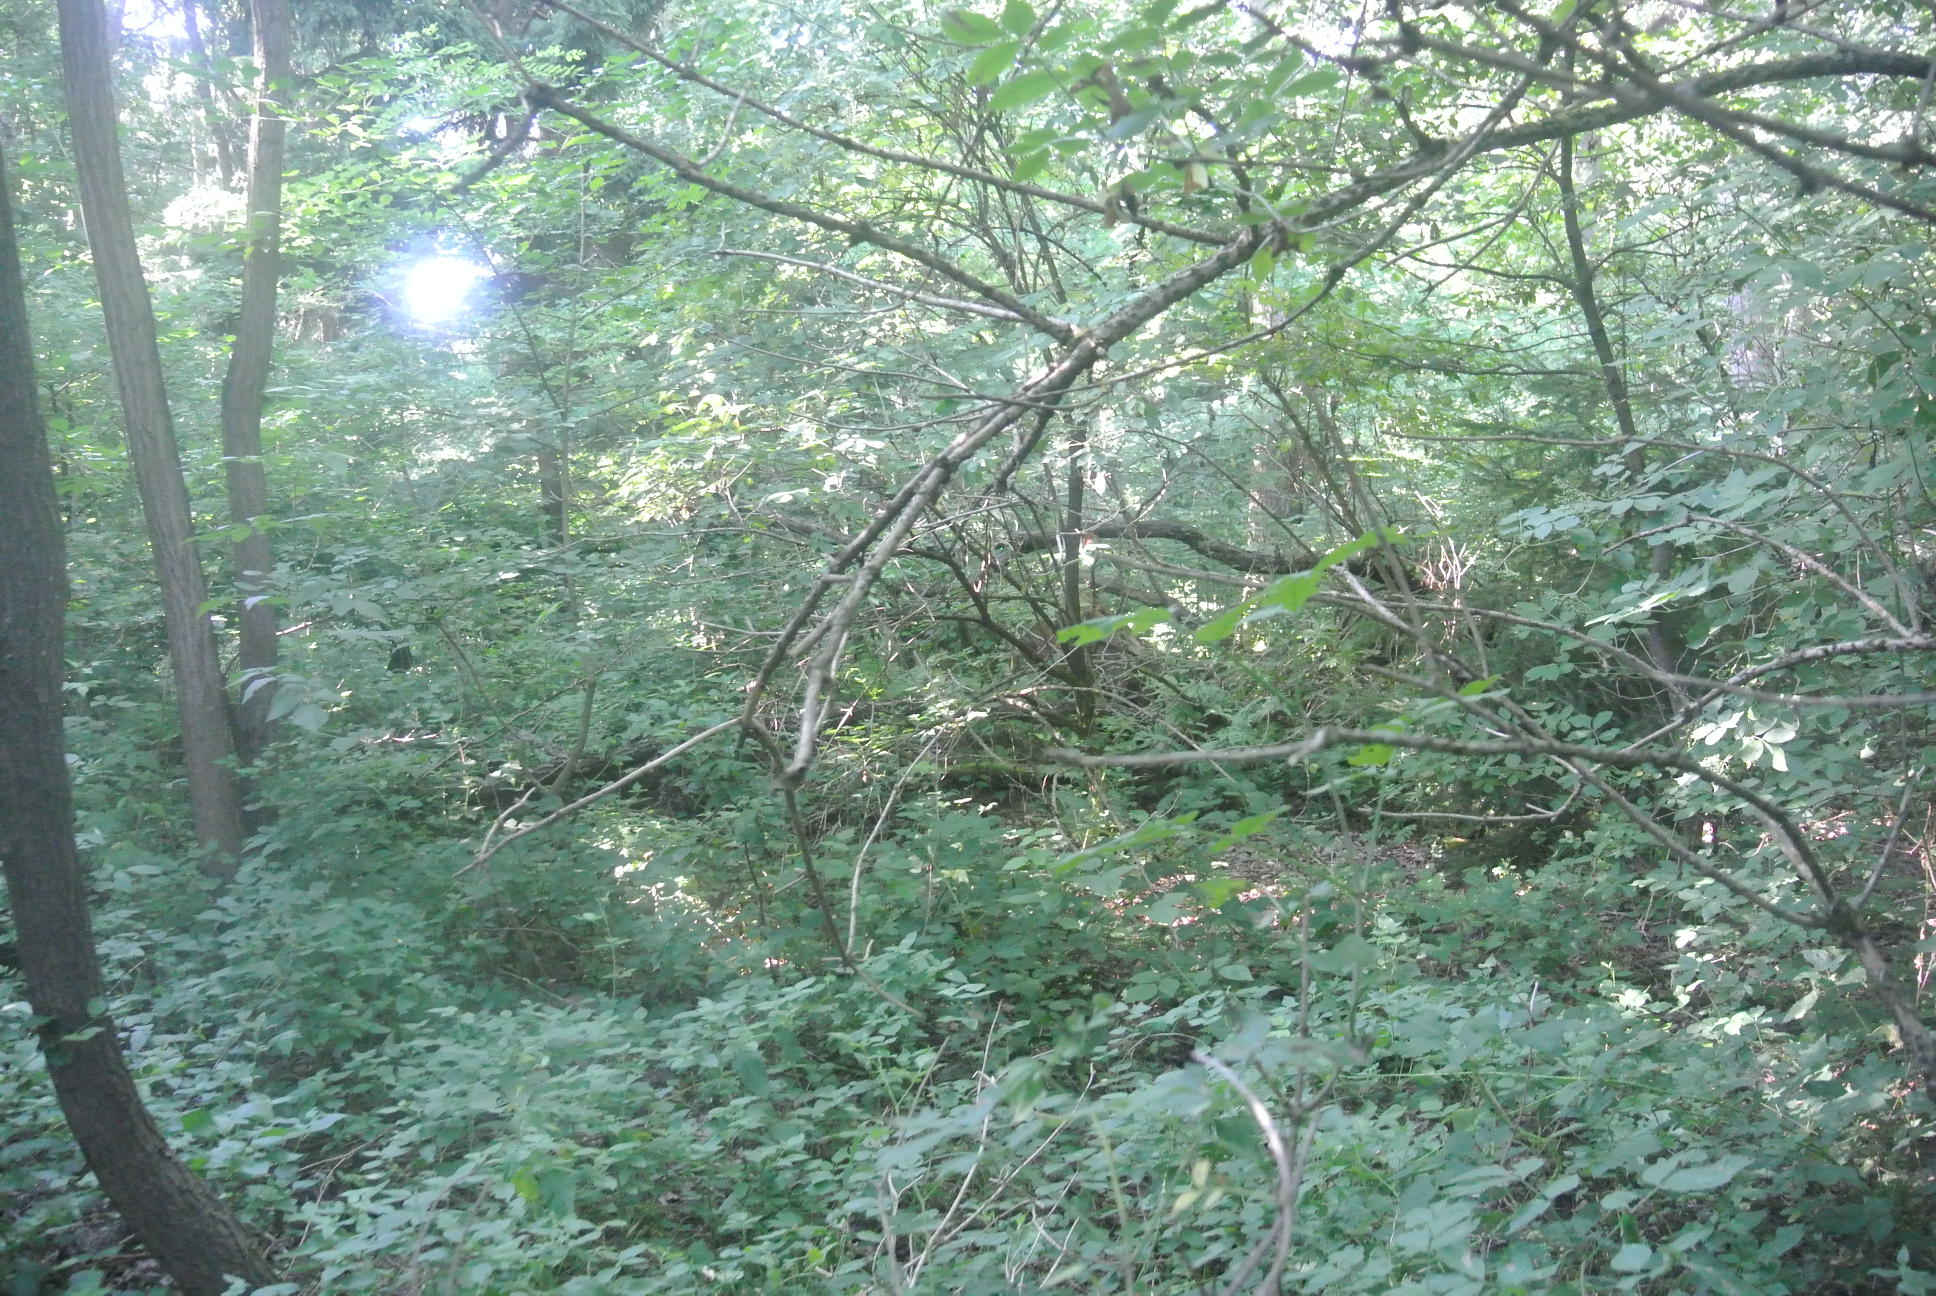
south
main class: Woodland
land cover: Broadleaved woodland
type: exotic forest
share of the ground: > 75 %
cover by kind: broadleaved forest trees 100 %
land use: Forestry
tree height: > 5 m
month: July
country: AT
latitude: 47.5652
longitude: 16.4502
